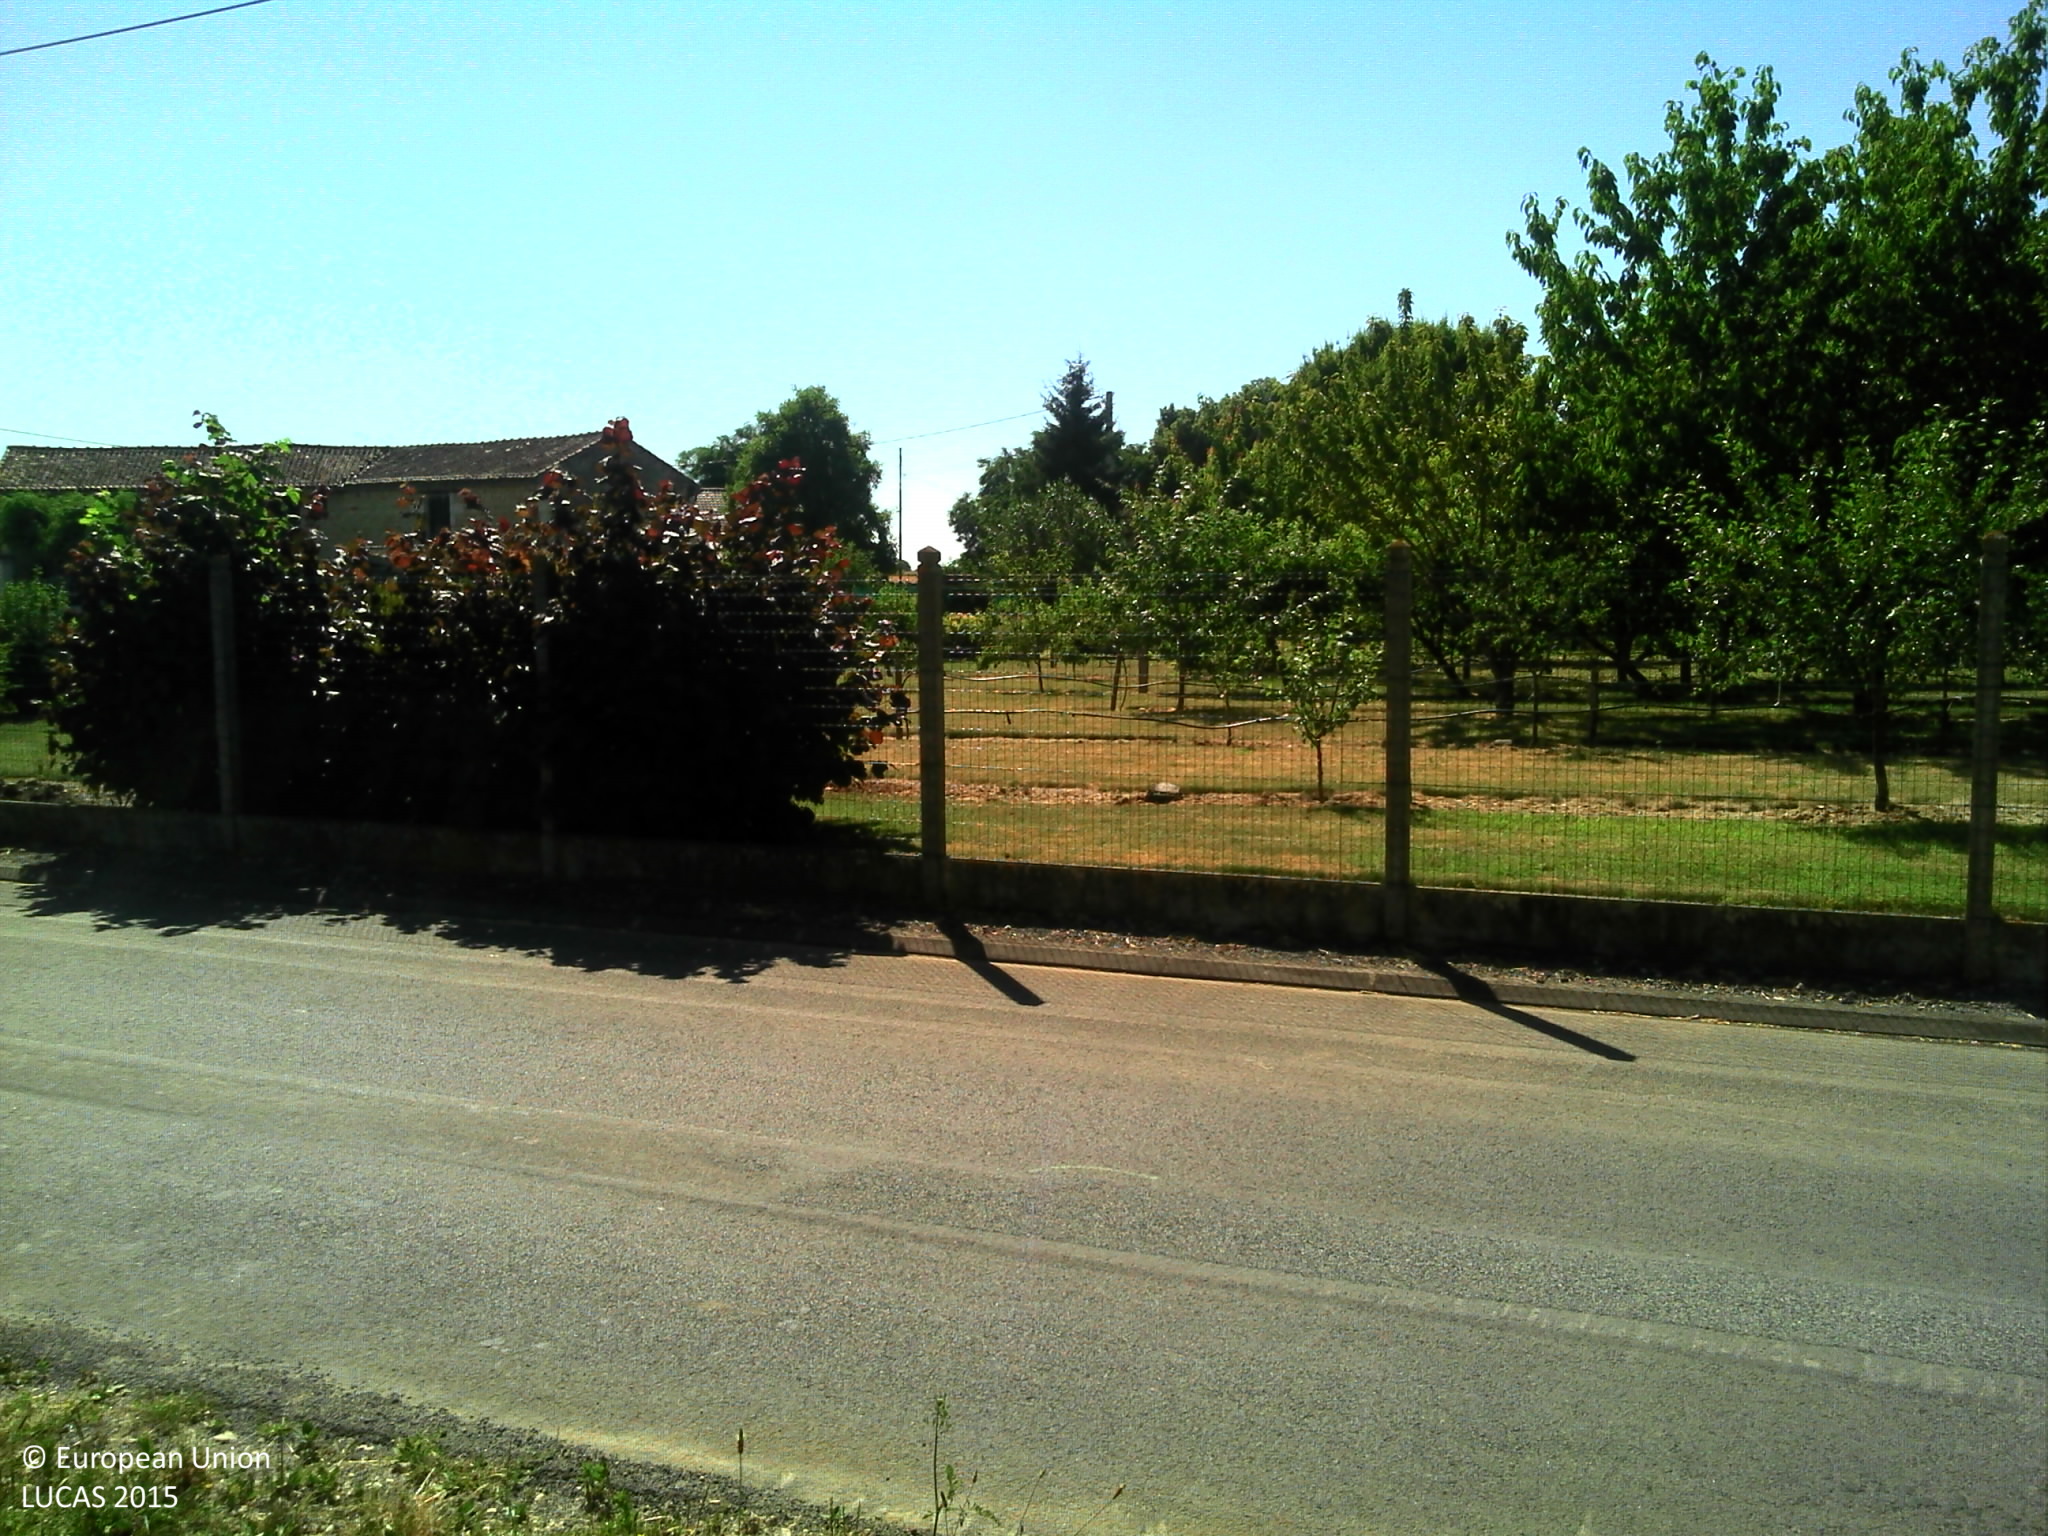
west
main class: Grassland
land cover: Spontaneously vegetated surfaces
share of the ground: > 75 %
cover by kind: herbaceous plants 100 %
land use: Semi-natural and natural areas not in use
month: June
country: FR
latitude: 46.8726
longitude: 0.1246
